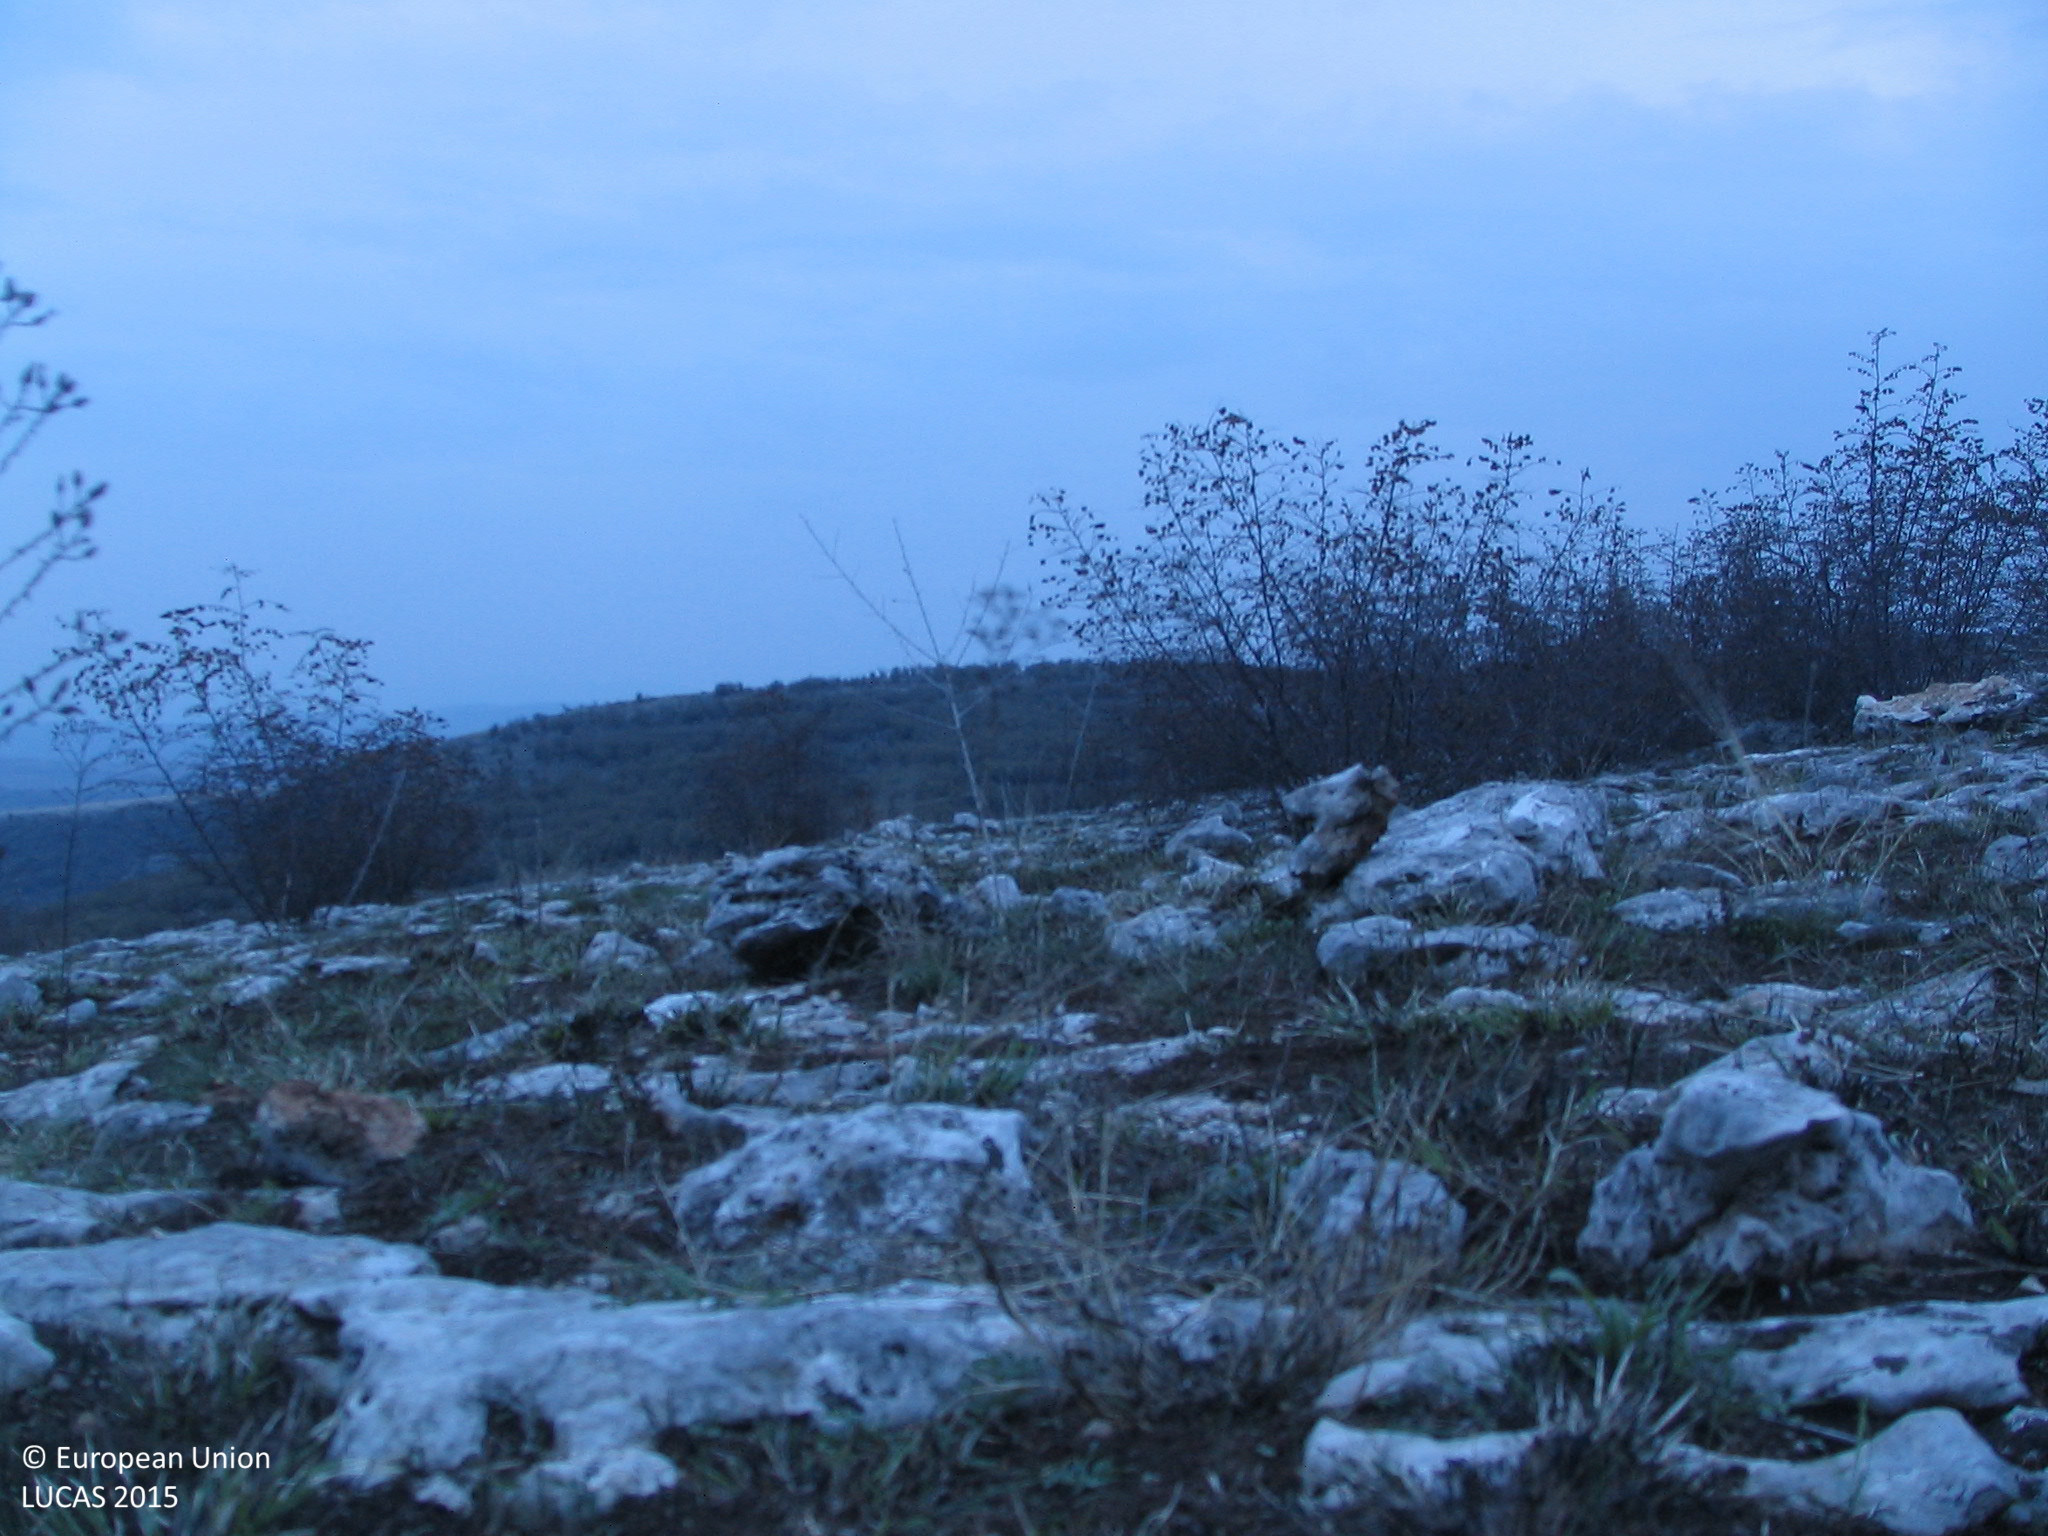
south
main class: Grassland
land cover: Grassland with sparse tree/shrub cover
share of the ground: 50 - 75 %
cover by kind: herbaceous plants 50 %, consolidated bare surface 40 %, broadleaved forest trees 5 %, shrubs 5 %
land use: Abandoned areas
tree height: < 5 m
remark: Burnt area
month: October
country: BG
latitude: 43.1934
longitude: 24.1419
